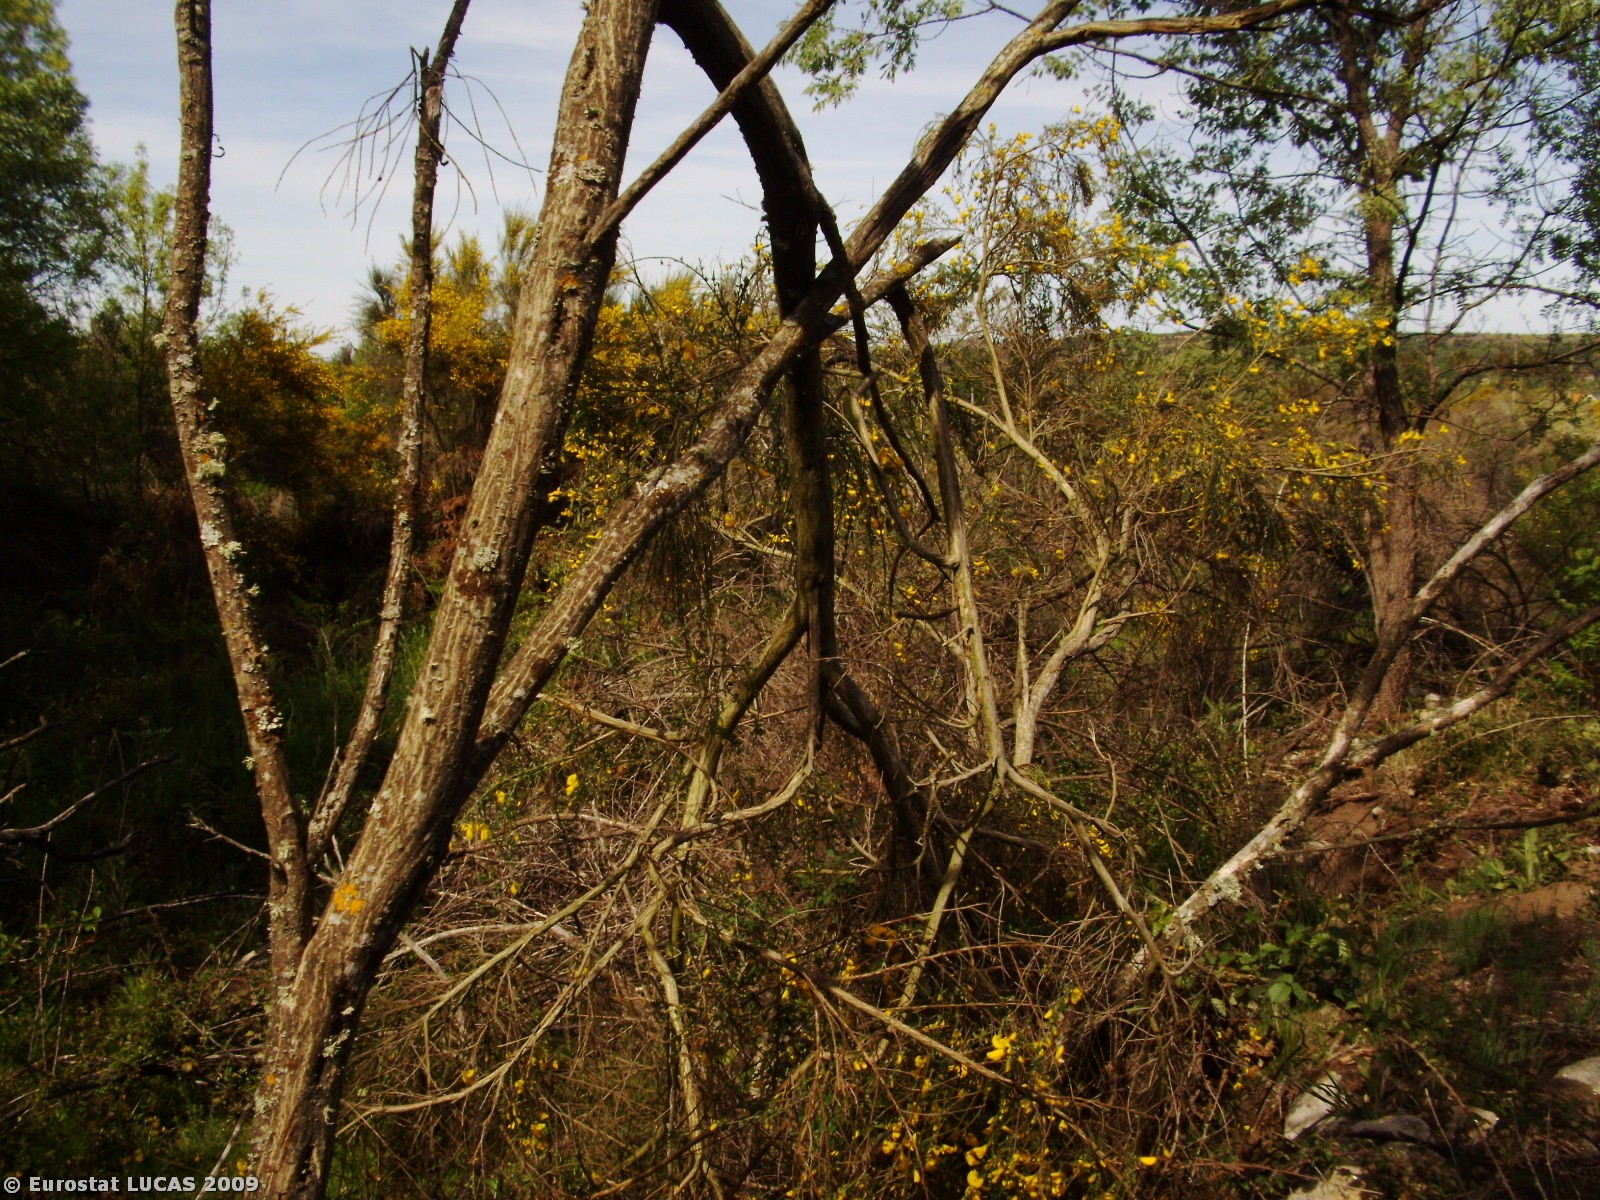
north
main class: Woodland
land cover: Broadleaved woodland
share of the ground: > 75 %
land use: Forestry
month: May
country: PT
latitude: 40.9756
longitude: -7.3591
